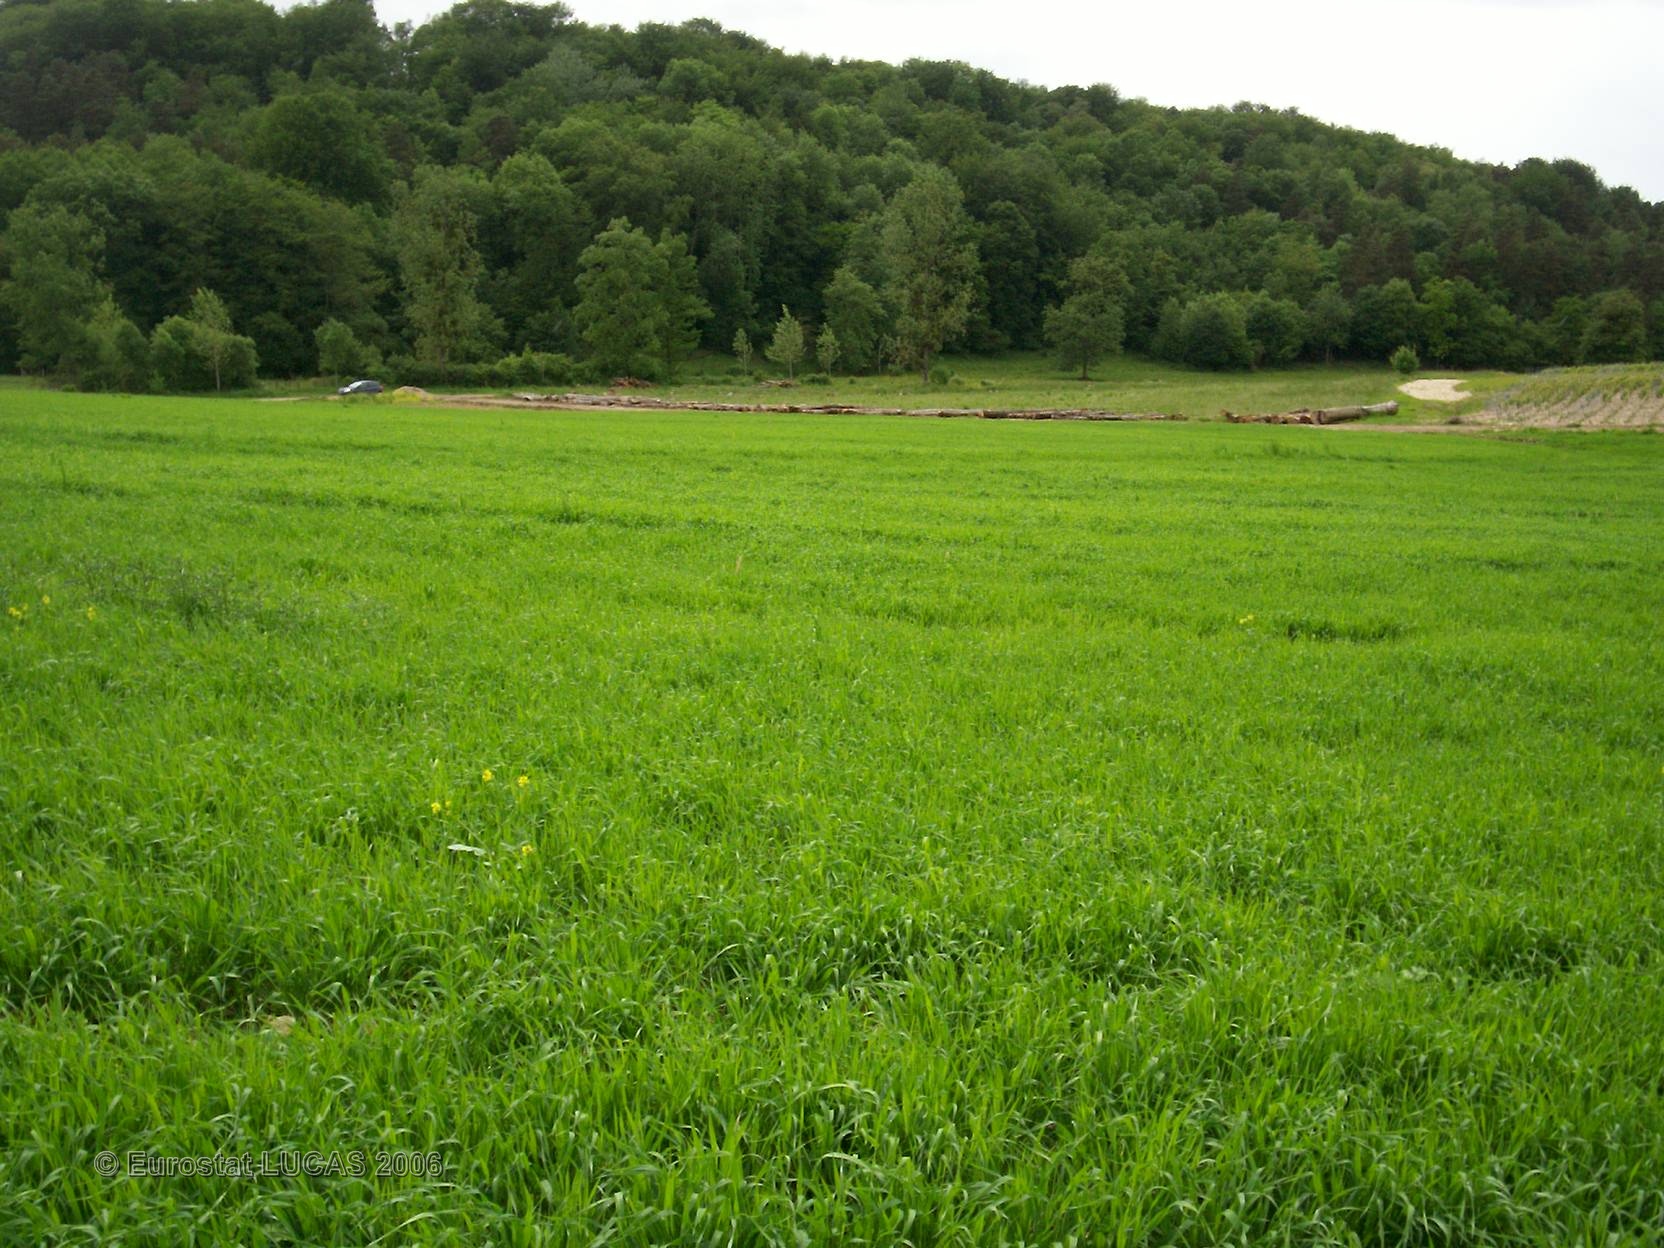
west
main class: Cropland
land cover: Barley
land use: Agriculture (excluding fallow land and kitchen gardens)
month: May
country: FR
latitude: 48.2035
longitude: 4.6832
